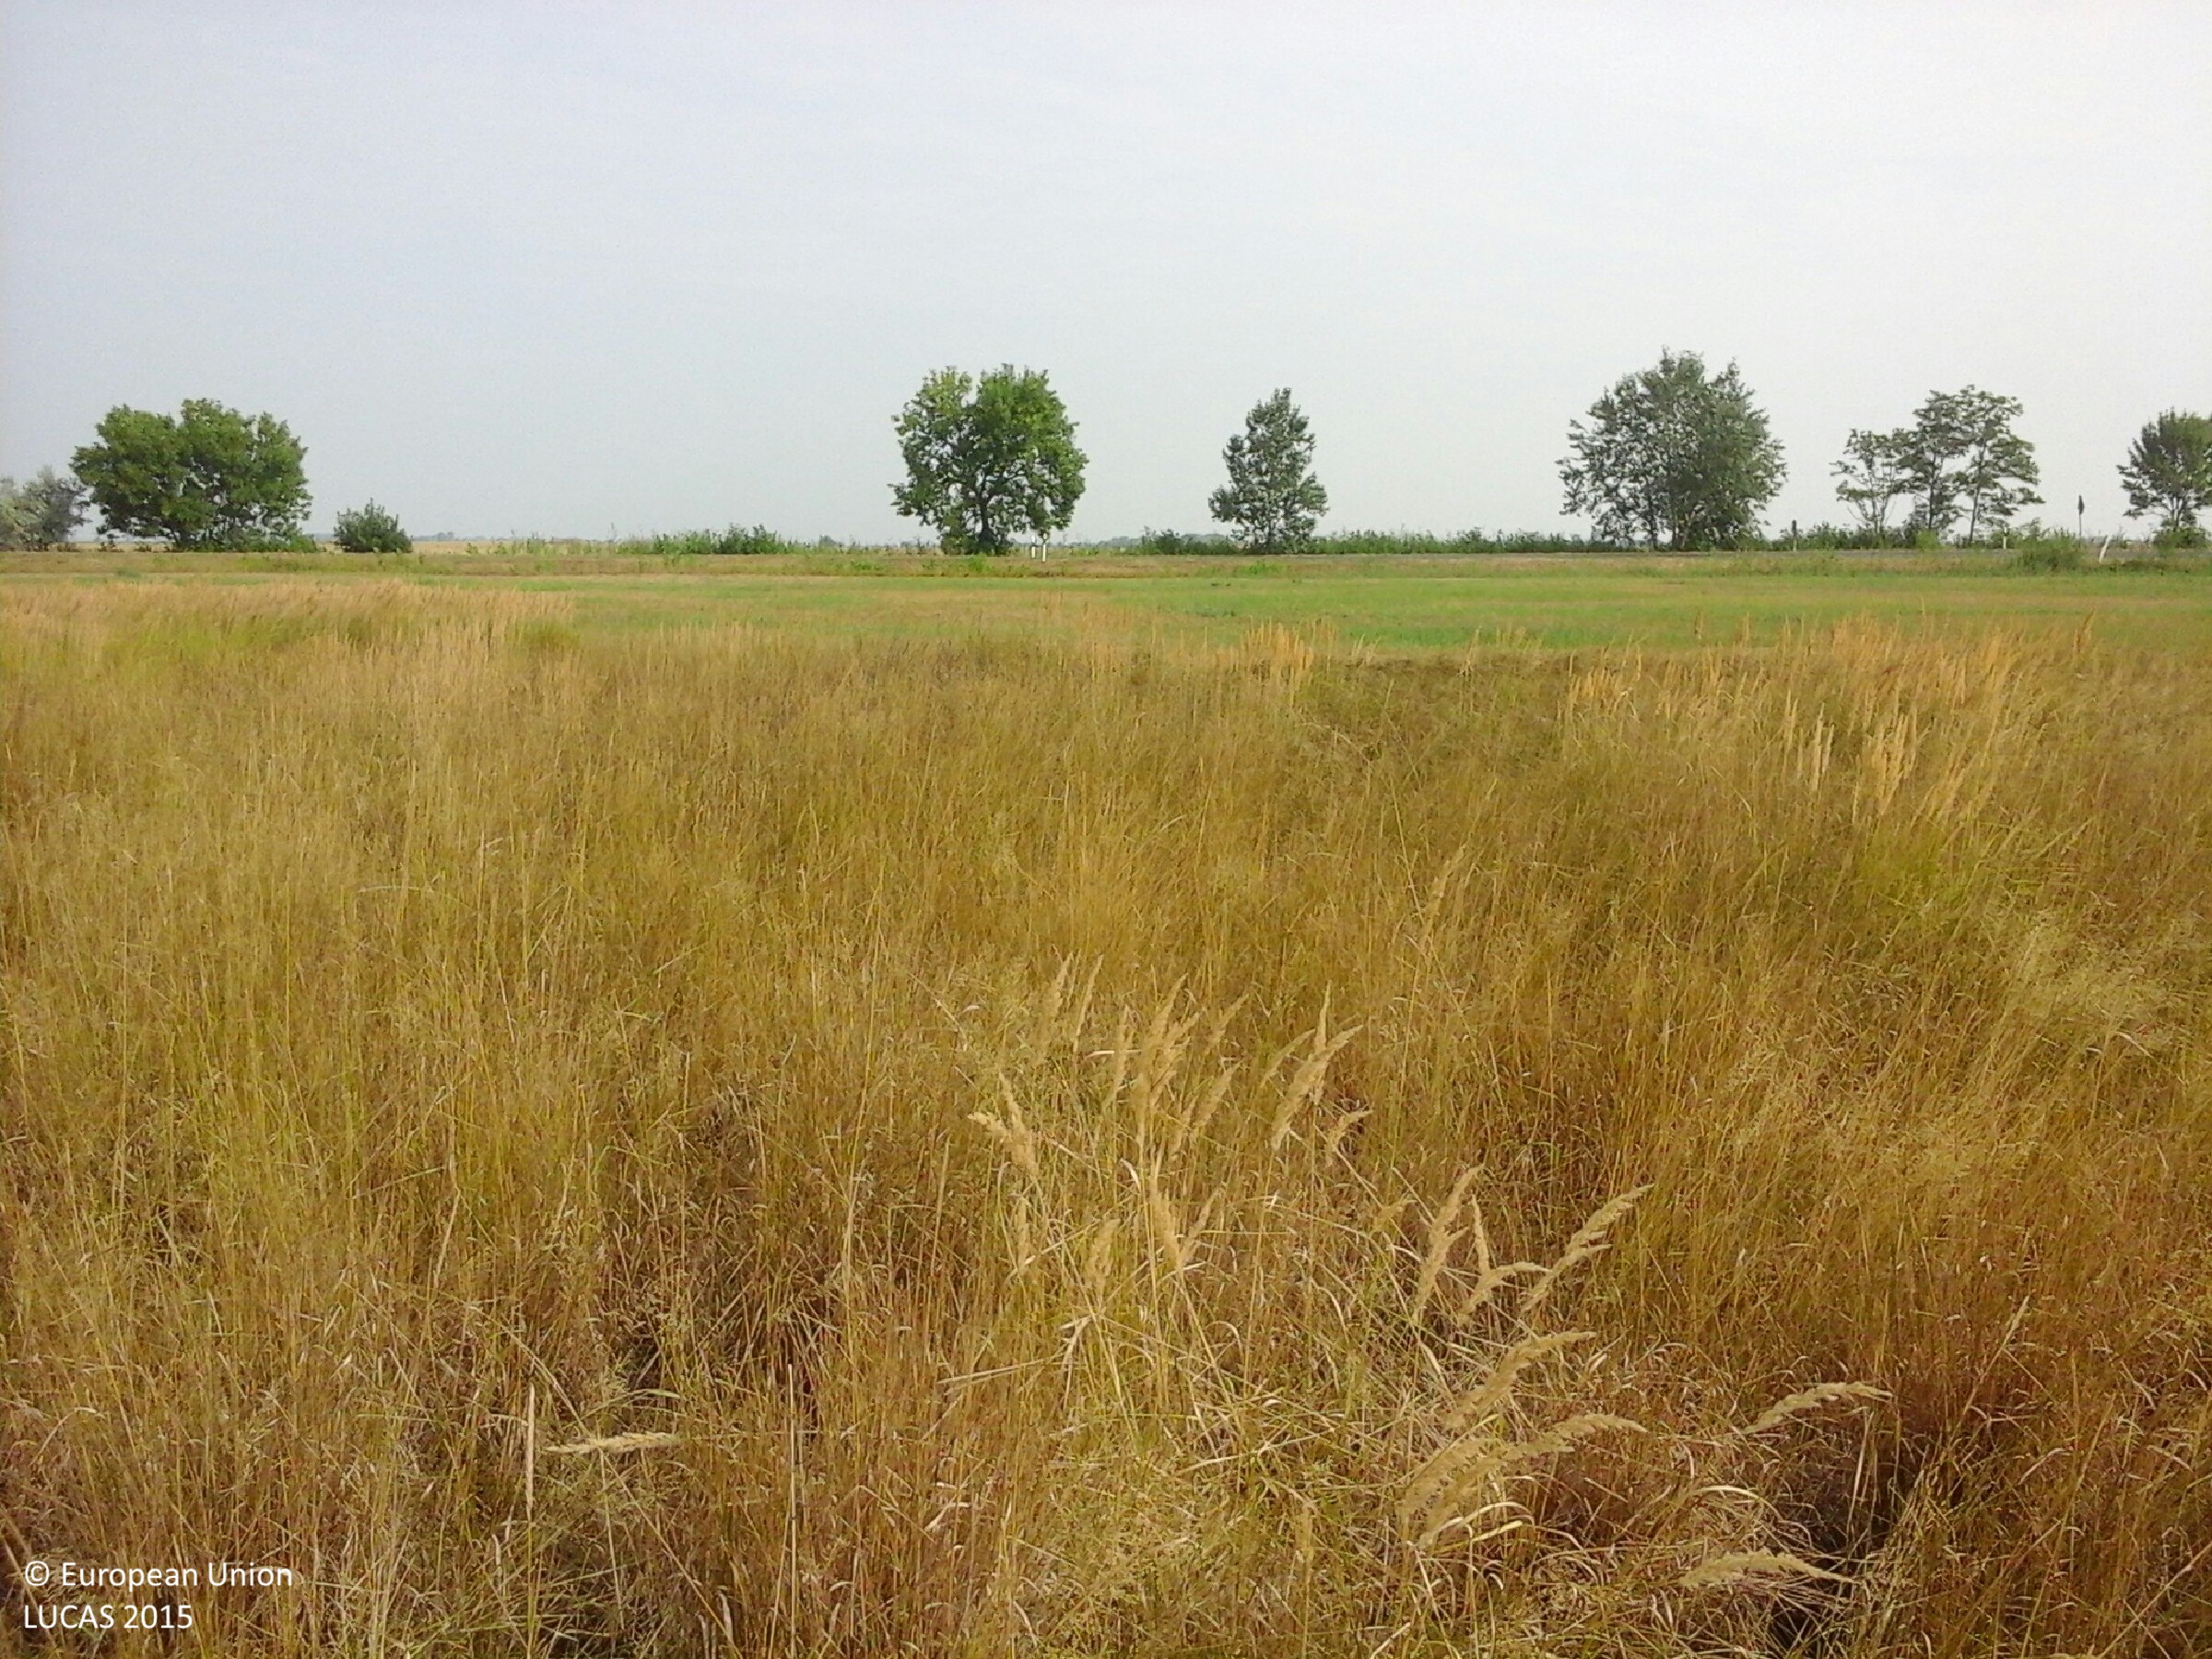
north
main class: Grassland
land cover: Grassland without tree/shrub cover
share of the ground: > 75 %
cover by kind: herbaceous plants 100 %
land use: Agriculture (excluding fallow land and kitchen gardens)
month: August
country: HU
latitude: 47.5497
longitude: 20.9454
